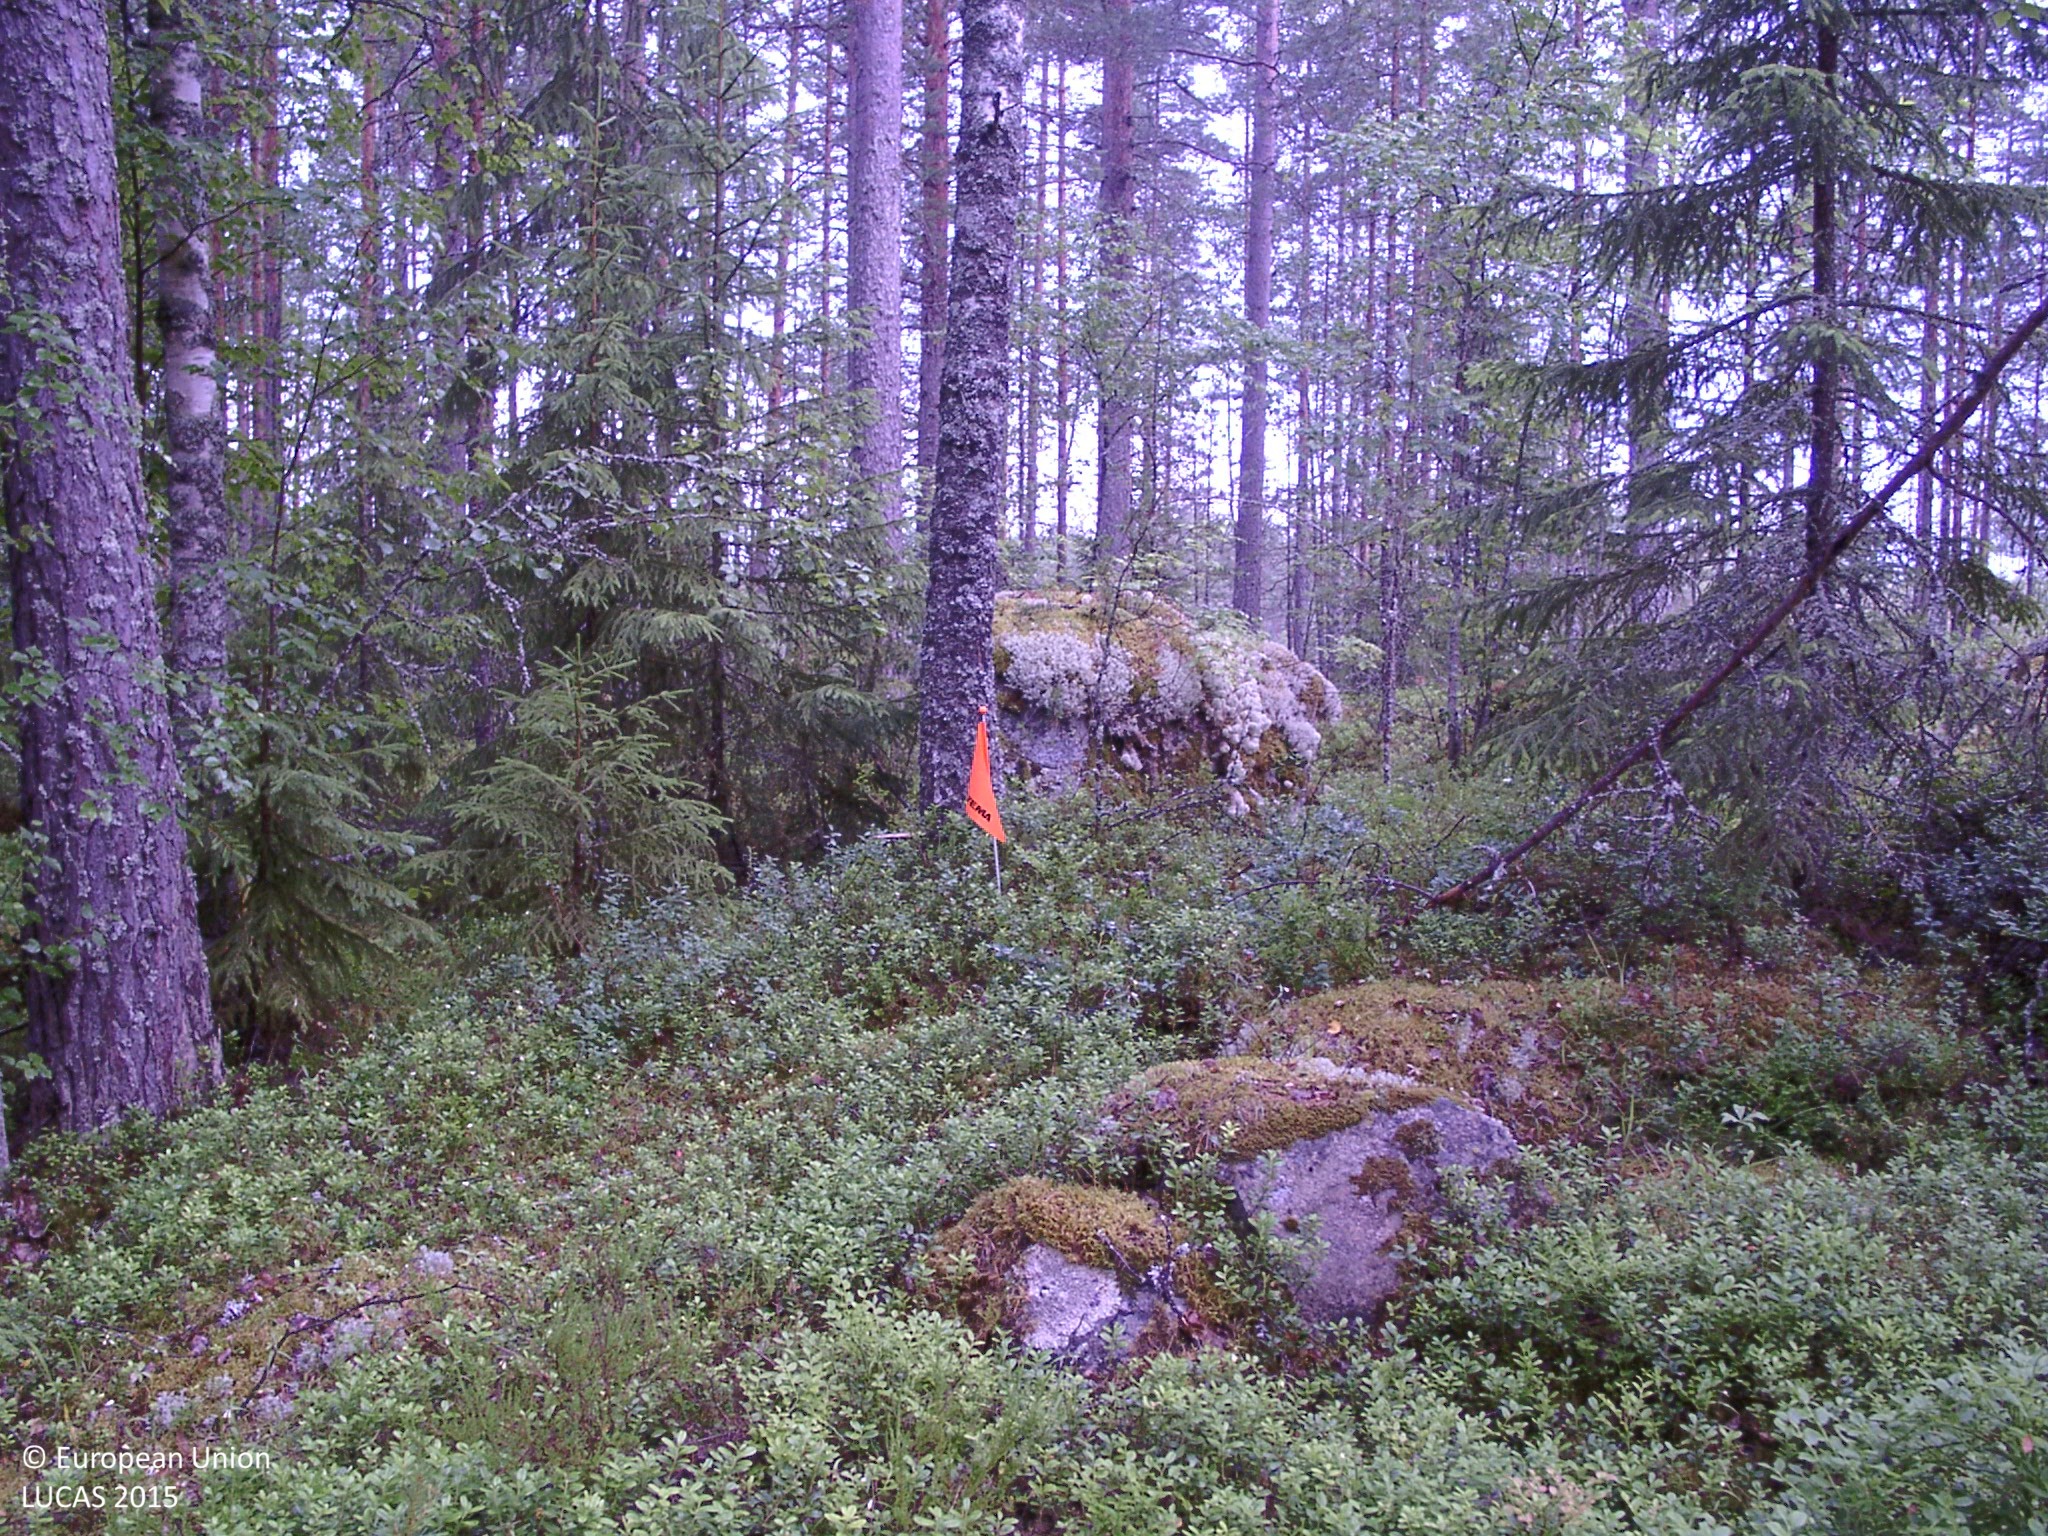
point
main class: Woodland
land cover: Other mixed woodland
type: boreal forest
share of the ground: 50 - 75 %
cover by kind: coniferous forest trees 35 %, broadleaved forest trees 30 %, shrubs 20 %, lichens and mosses 15 %
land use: Forestry
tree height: > 5 m
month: July
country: FI
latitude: 61.8474
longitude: 24.7101
